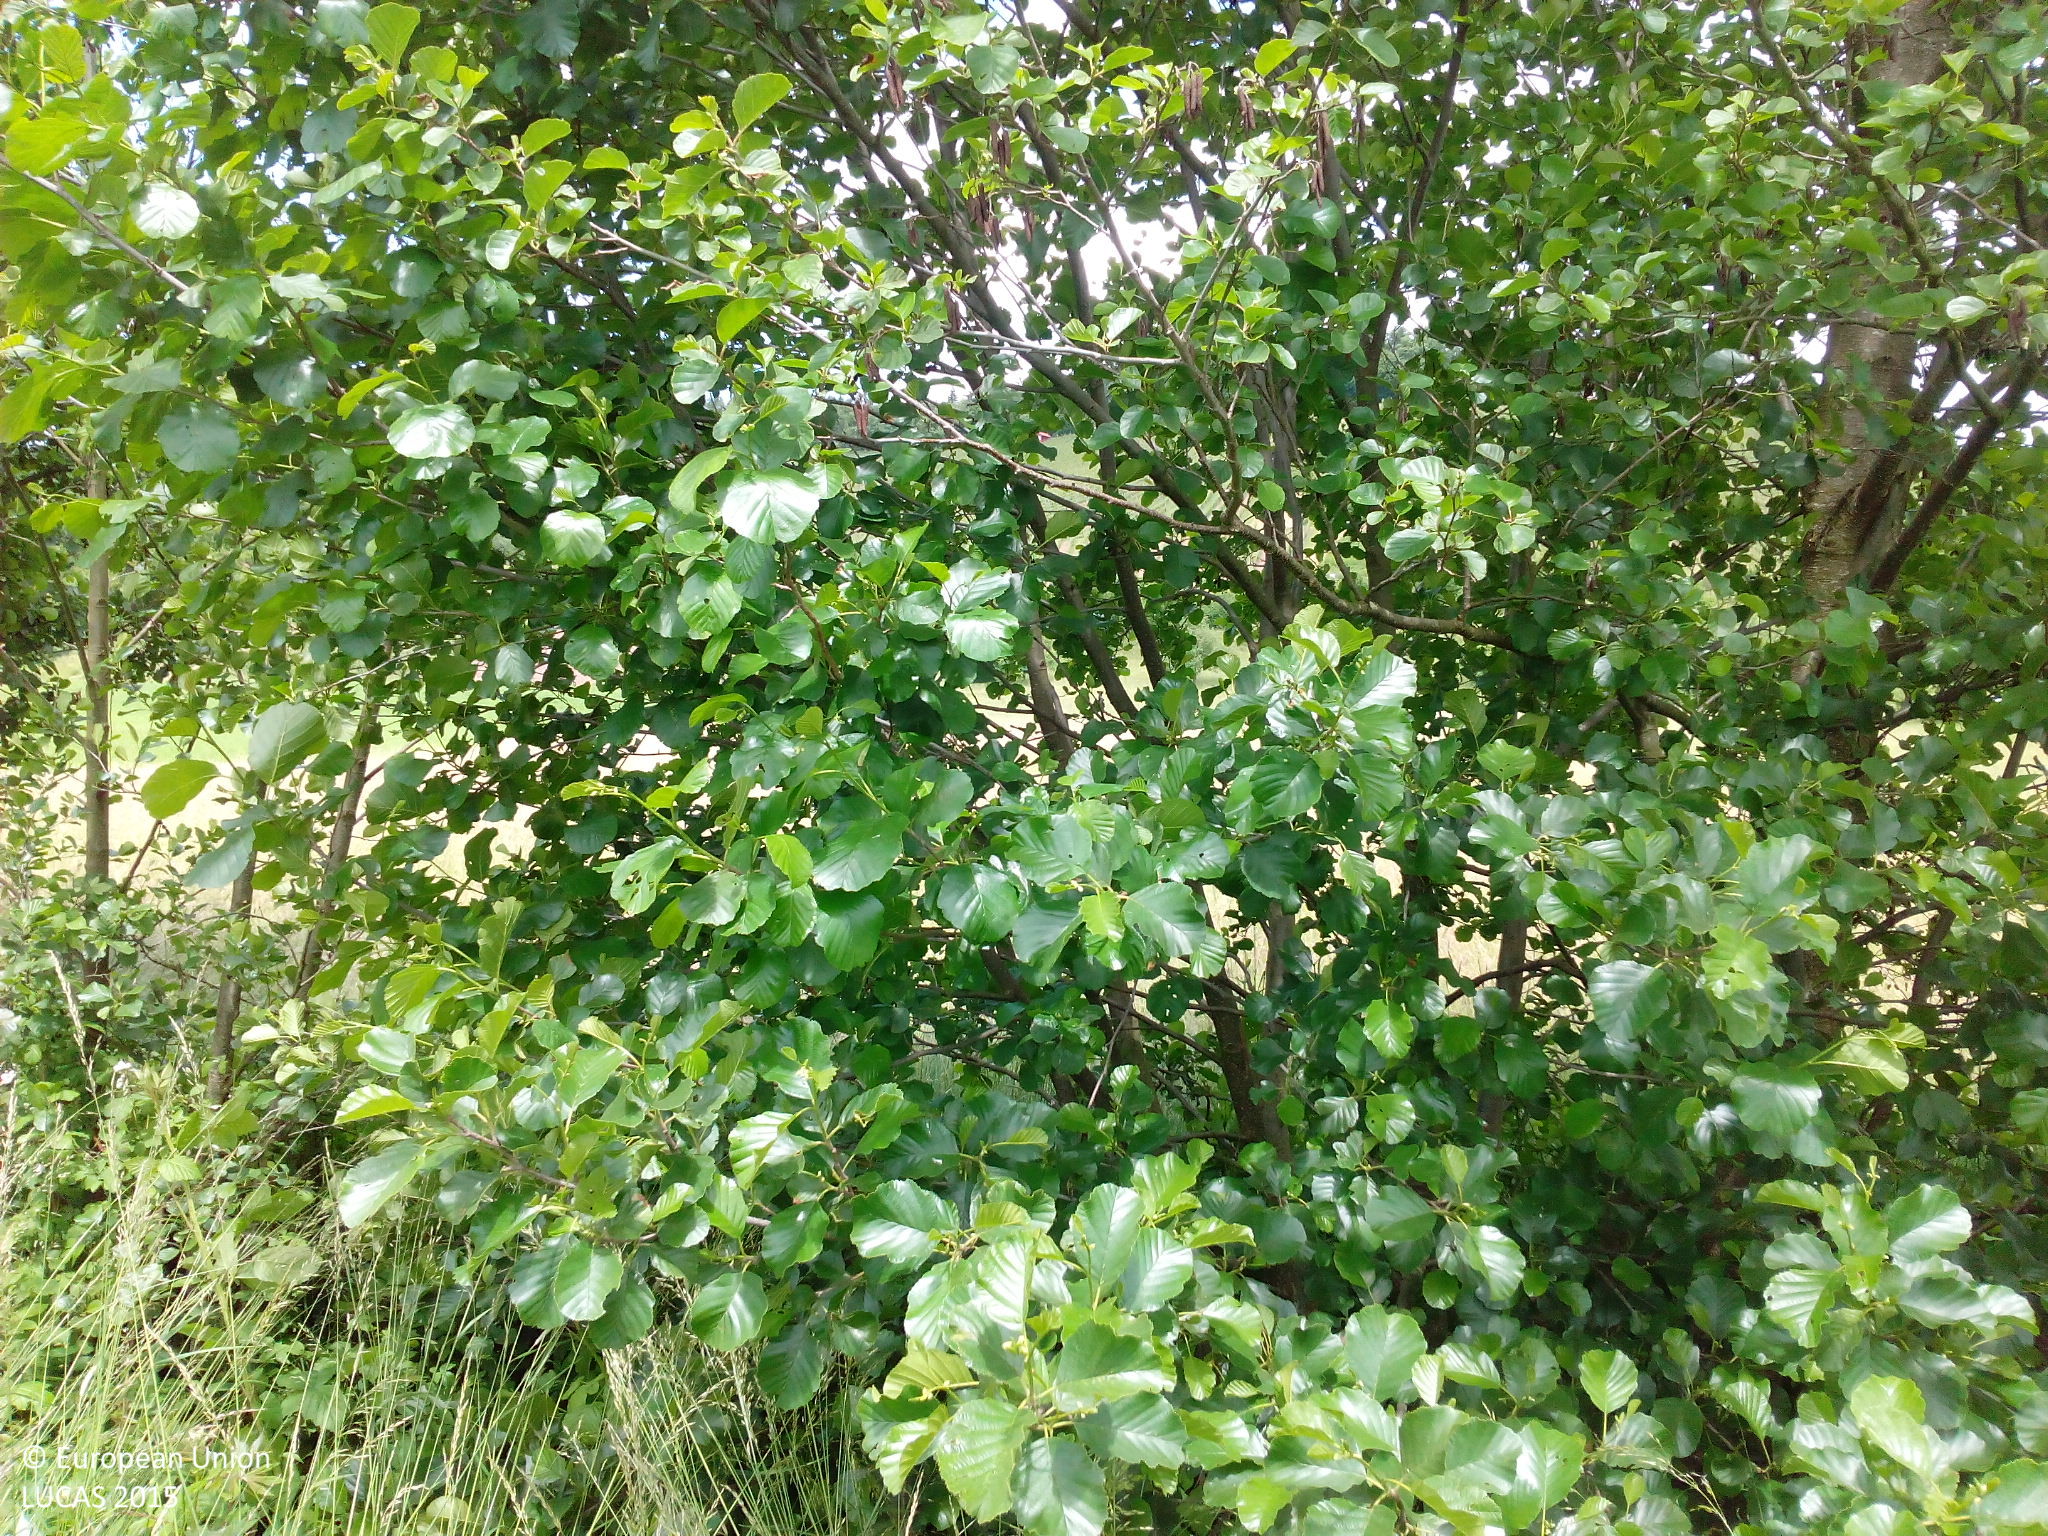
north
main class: Grassland
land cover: Grassland without tree/shrub cover
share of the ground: > 75 %
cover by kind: herbaceous plants 100 %
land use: Agriculture (excluding fallow land and kitchen gardens)
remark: Harvested field
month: June
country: DE
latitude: 48.9955
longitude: 9.3852
